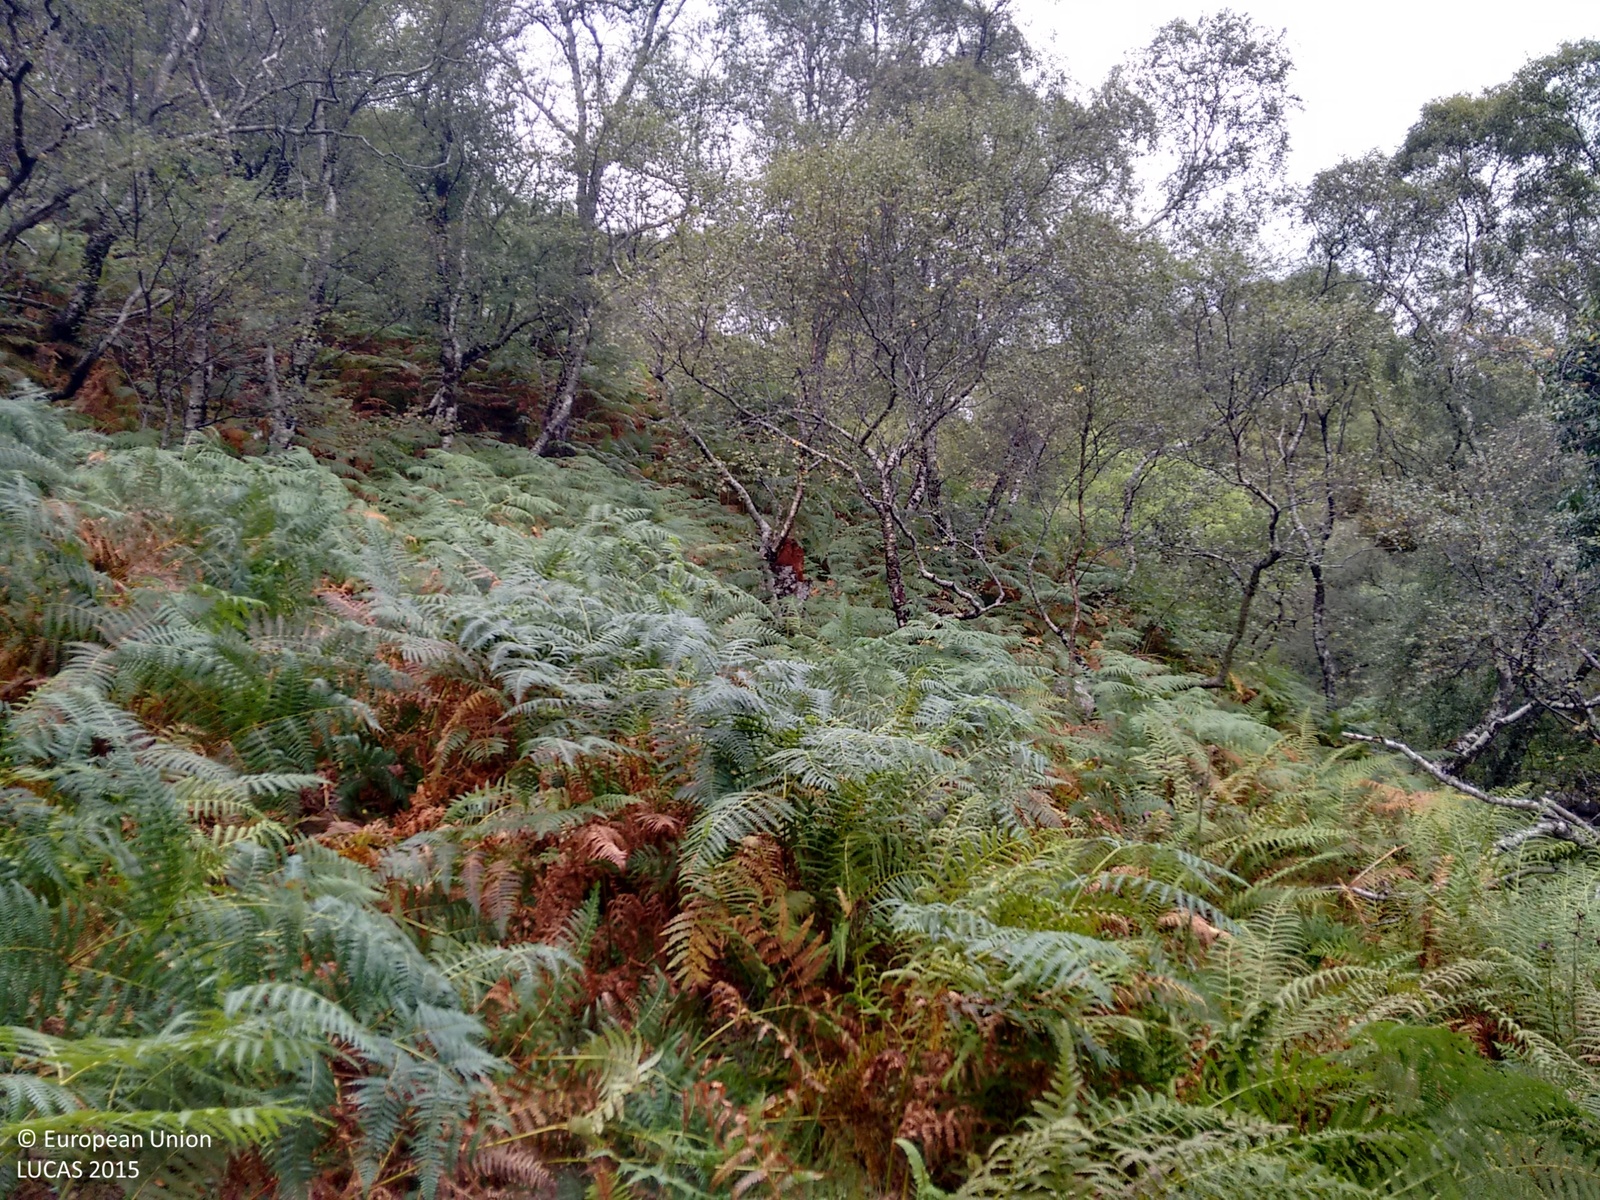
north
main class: Woodland
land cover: Broadleaved woodland
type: floodplain forest
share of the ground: > 75 %
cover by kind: broadleaved forest trees 90 %, herbaceous plants 10 %
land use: Agriculture (excluding fallow land and kitchen gardens)
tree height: > 5 m
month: September
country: GB
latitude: 57.5268
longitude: -5.7007
